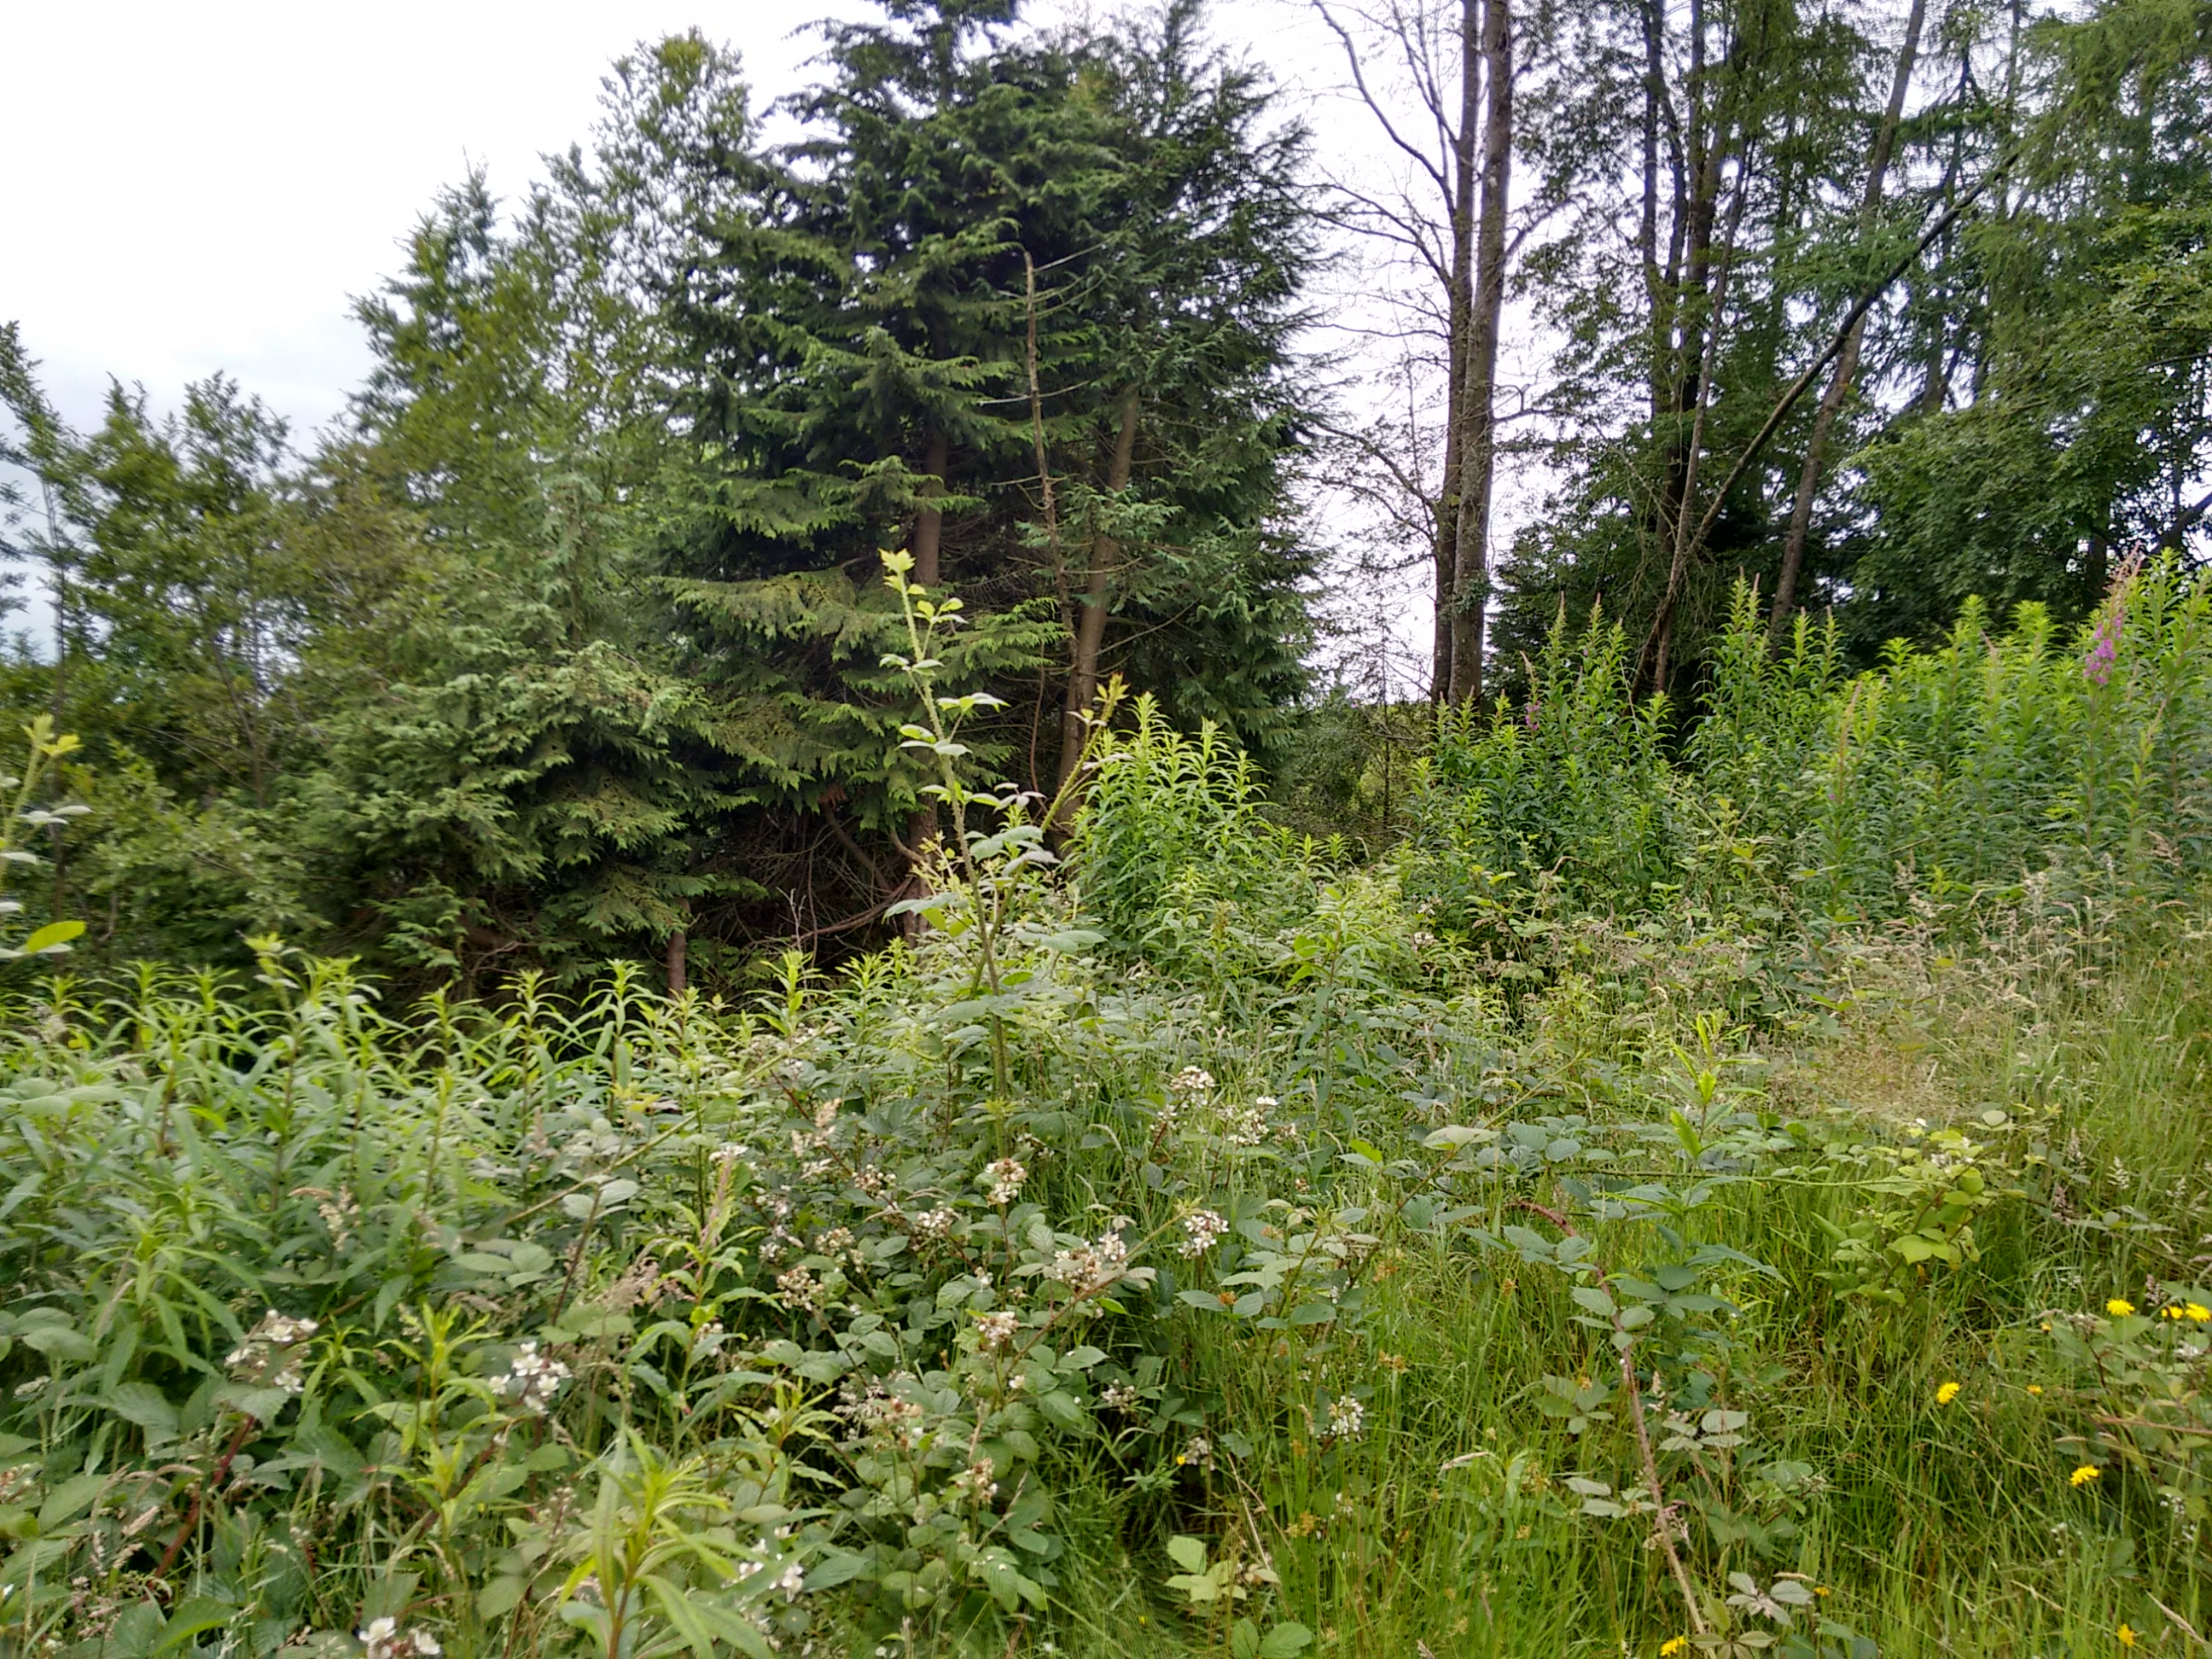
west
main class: Woodland
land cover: Other mixed woodland
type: hemiboreal forest and nemoral coniferous forest and mixed broadleaved-coniferous forest
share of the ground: > 75 %
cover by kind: coniferous forest trees 50 %, broadleaved forest trees 50 %
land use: Forestry
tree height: > 5 m
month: July
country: GB
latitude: 54.6474
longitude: -7.1762
